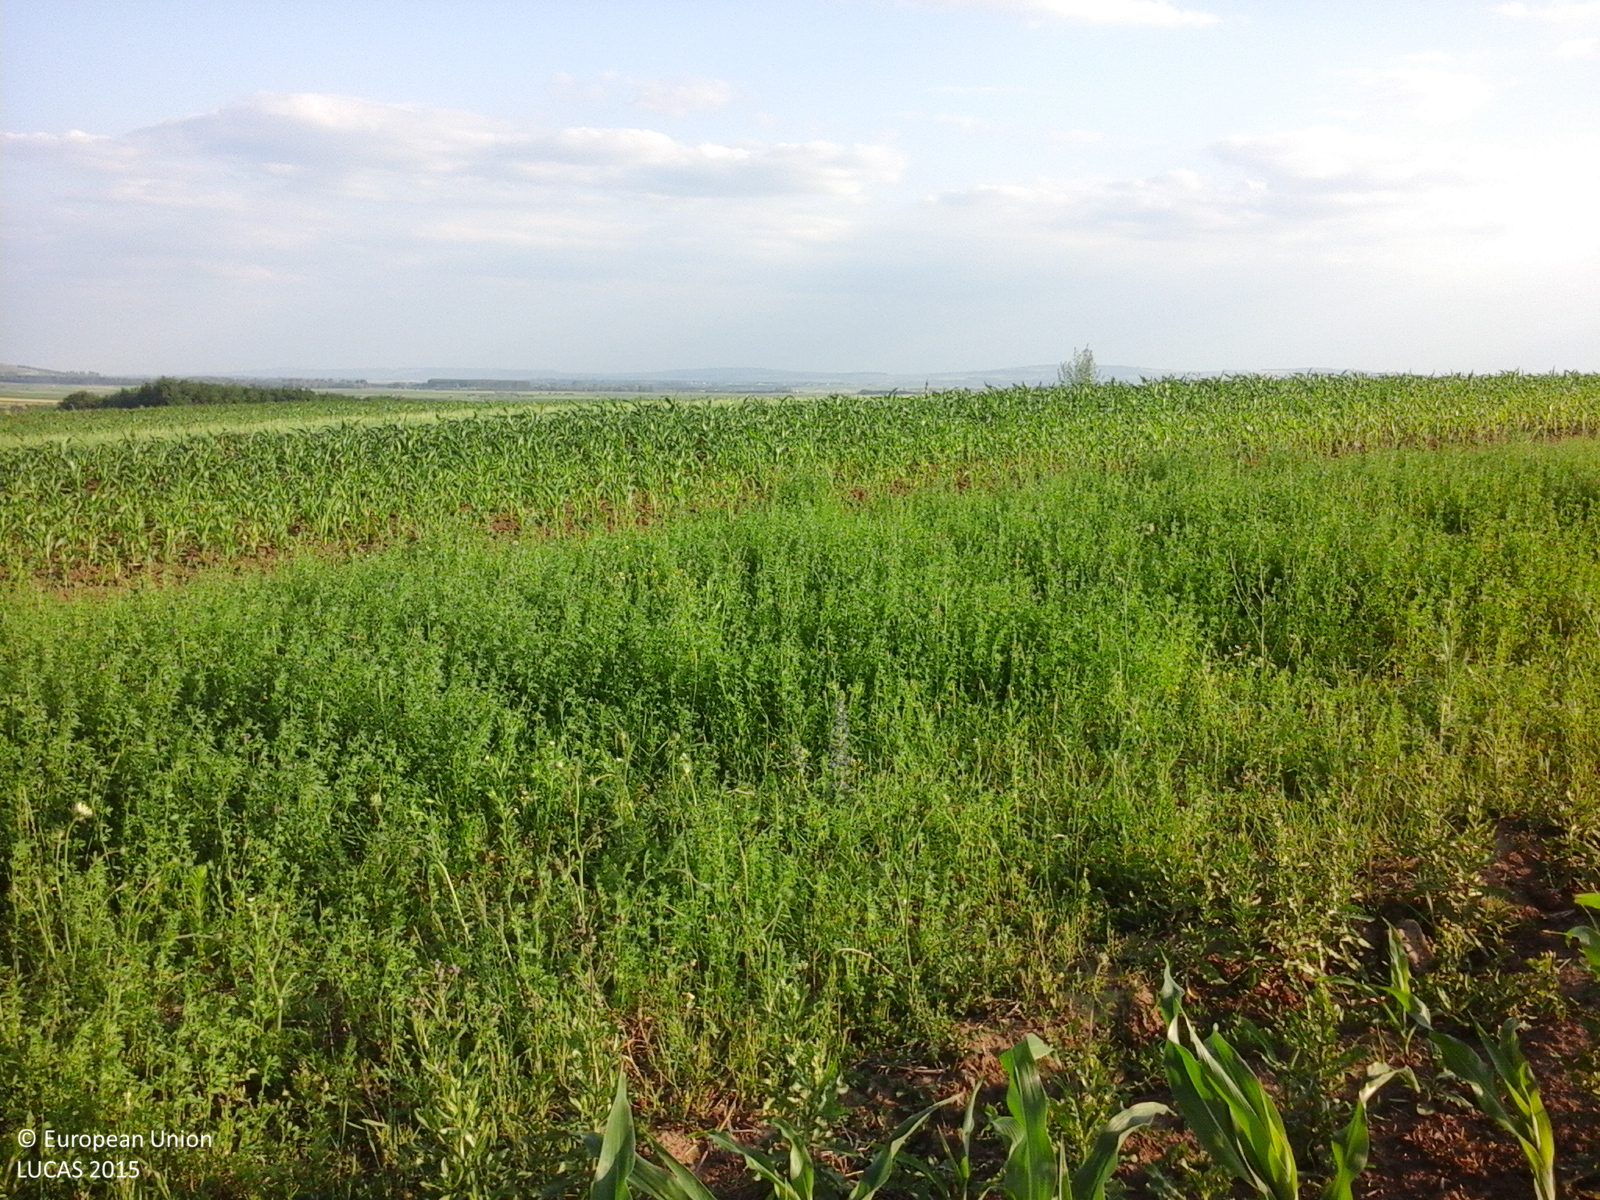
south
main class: Cropland
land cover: Maize
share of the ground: 25 - 50 %
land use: Agriculture (excluding fallow land and kitchen gardens)
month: June
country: RO
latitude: 47.7080
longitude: 26.4692
